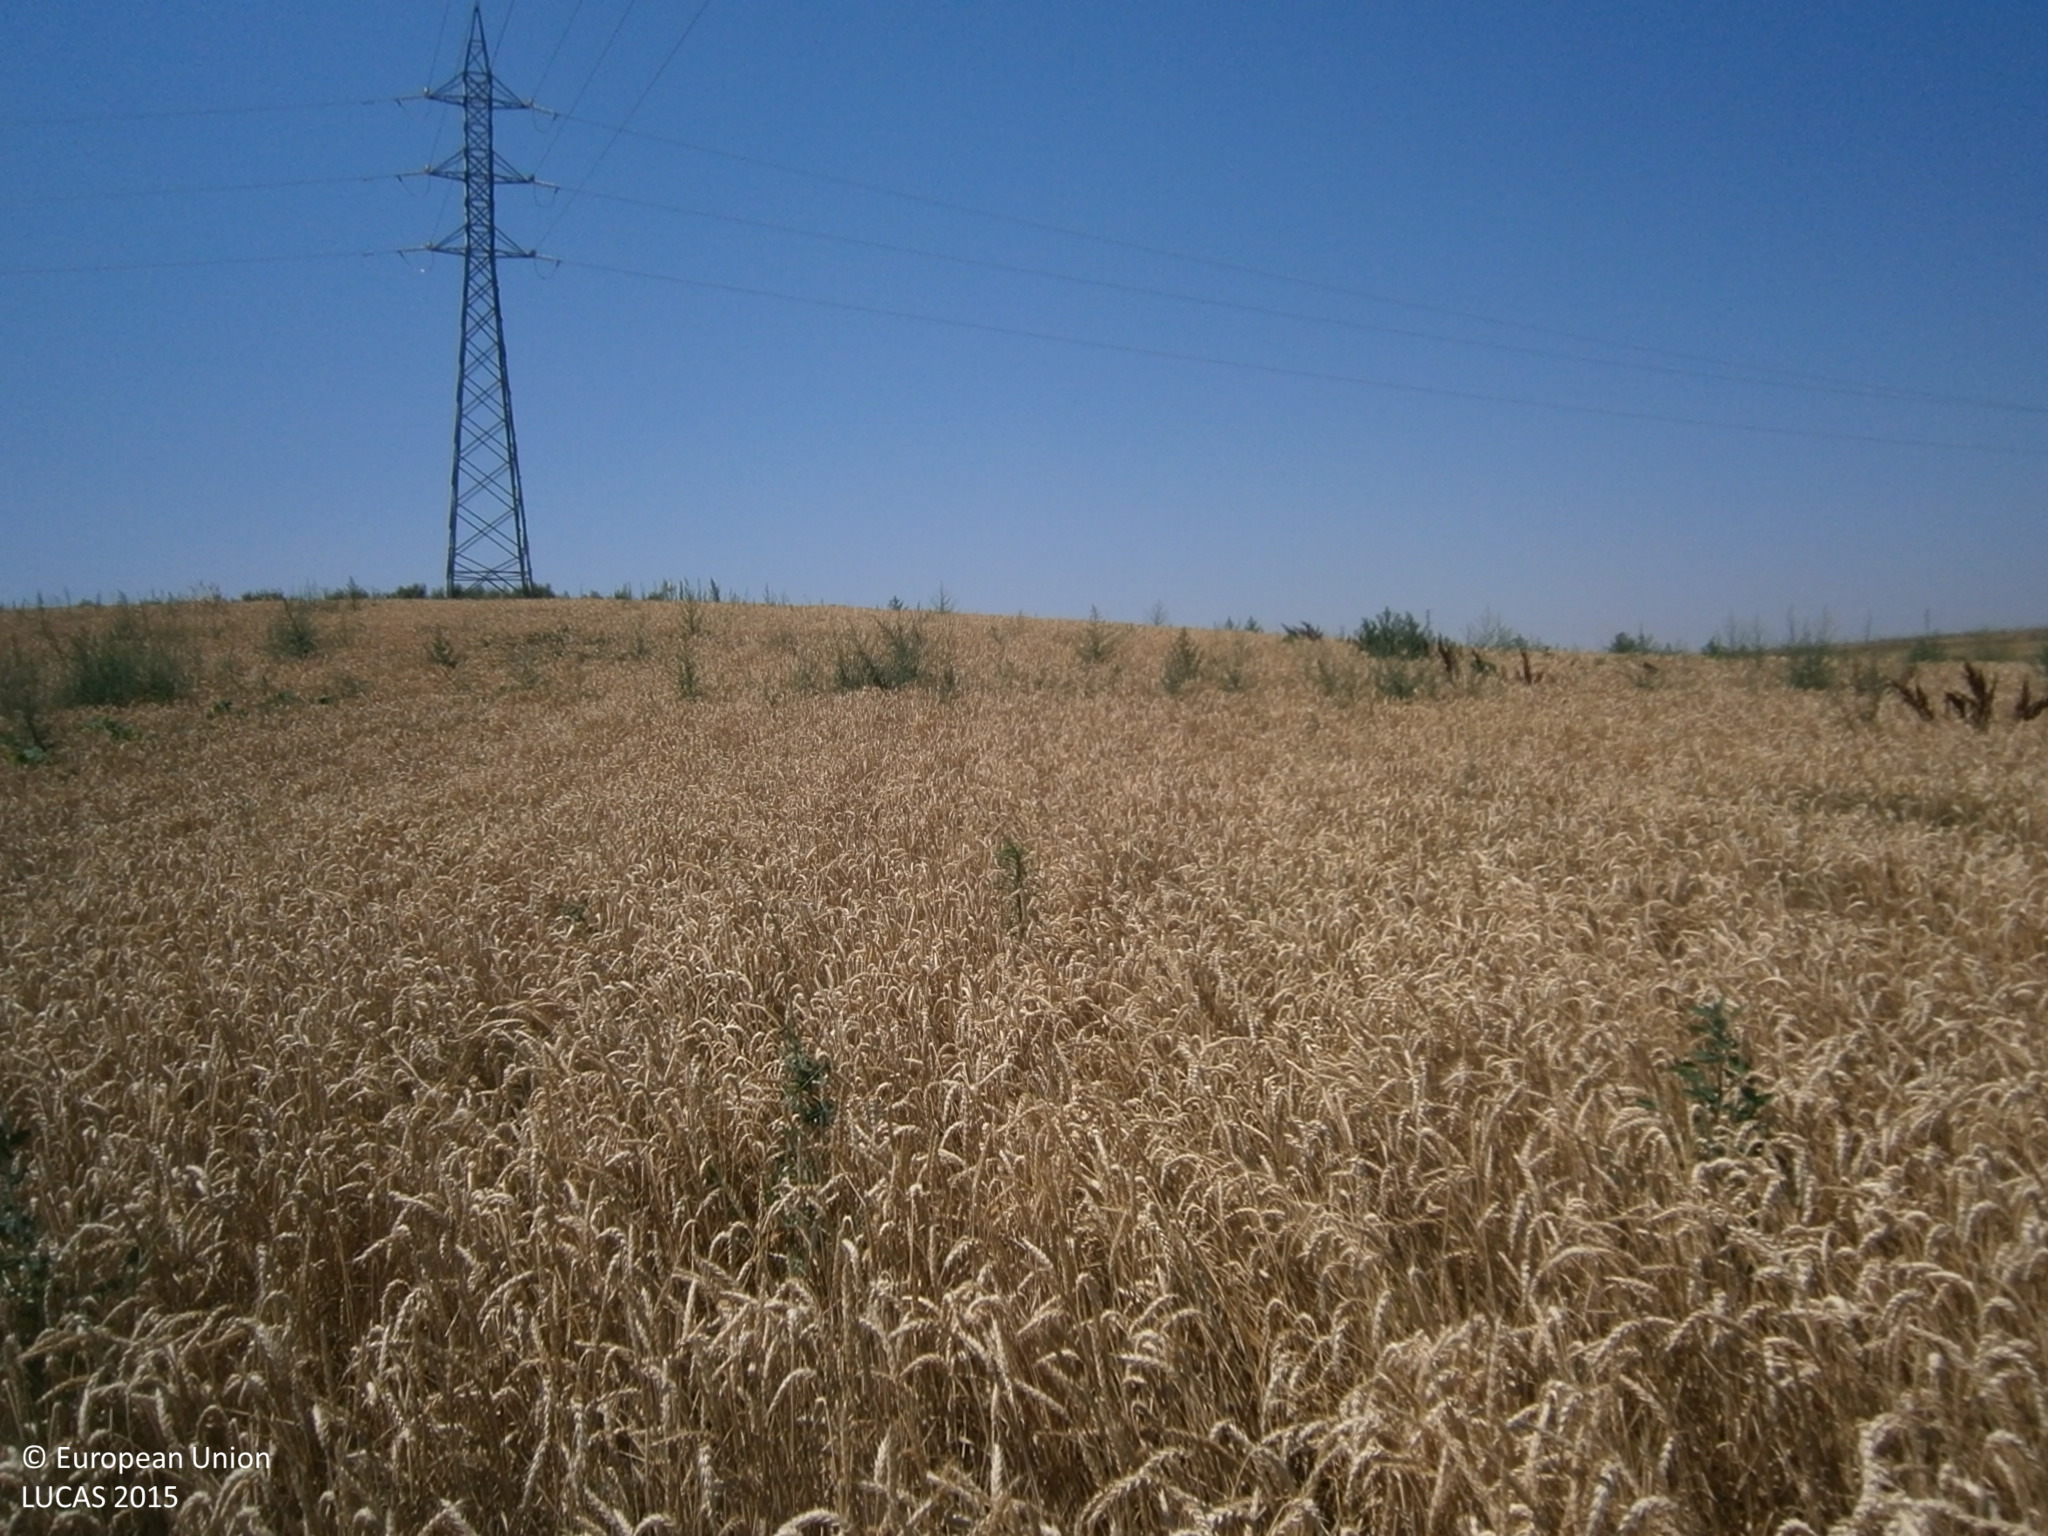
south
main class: Cropland
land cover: Barley
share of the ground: > 75 %
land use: Agriculture (excluding fallow land and kitchen gardens)
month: June
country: ES
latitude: 38.8449
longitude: -6.6889
